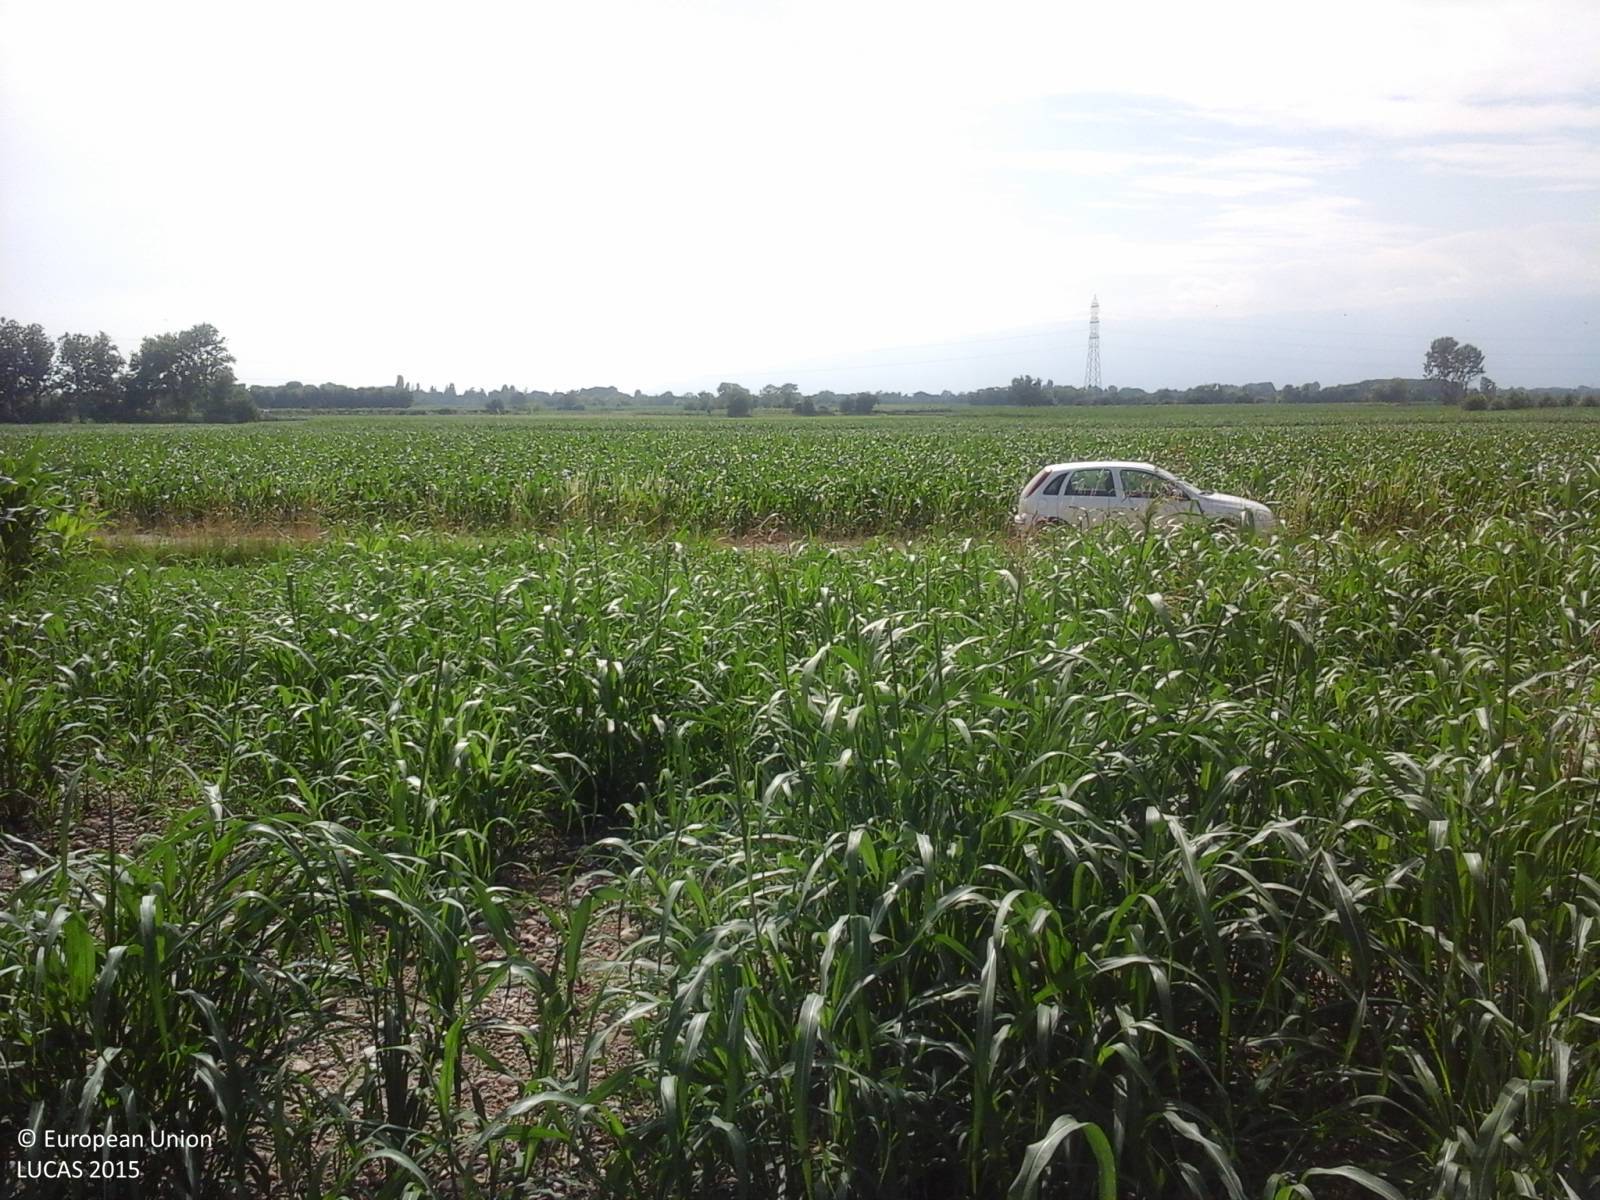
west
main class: Cropland
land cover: Maize
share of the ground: > 75 %
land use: Agriculture (excluding fallow land and kitchen gardens)
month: June
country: IT
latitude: 46.0102
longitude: 12.7217
